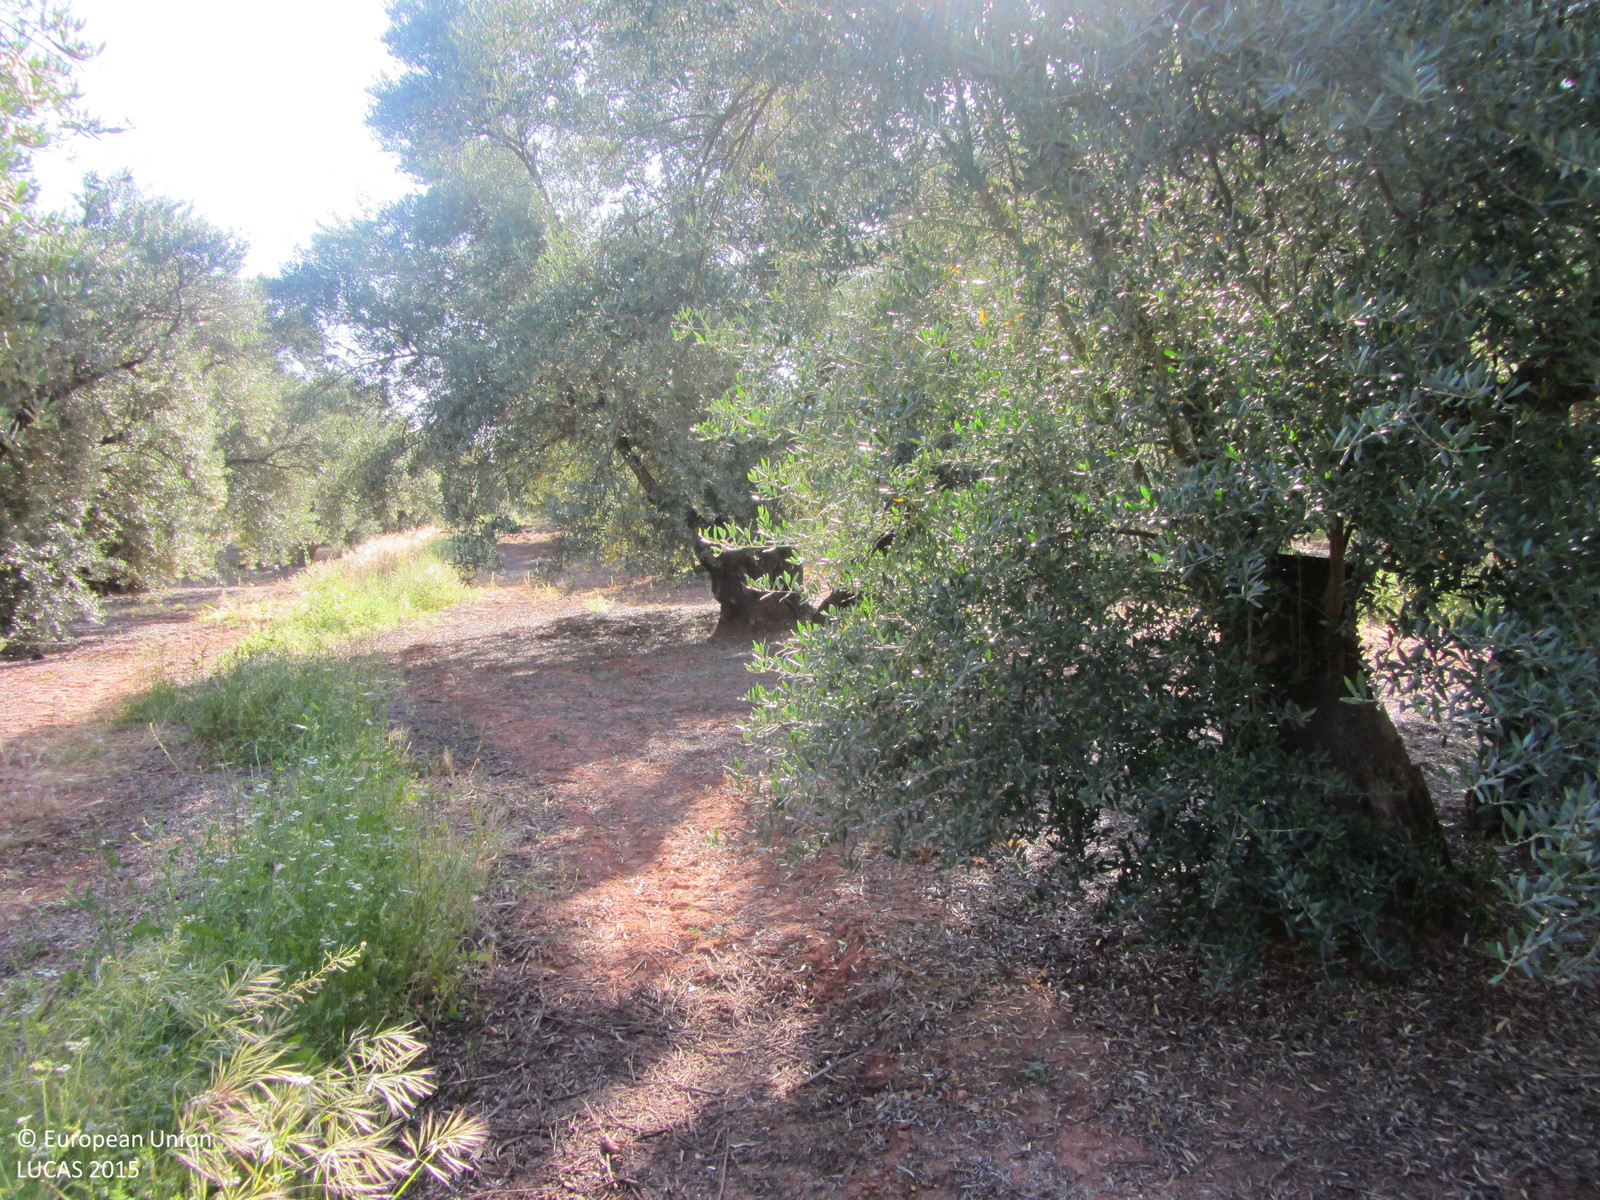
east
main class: Cropland
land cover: Olive groves
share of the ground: 50 - 75 %
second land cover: Spontaneously vegetated surfaces
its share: 10 - 25 %
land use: Agriculture (excluding fallow land and kitchen gardens)
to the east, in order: Olive groves; Spontaneously vegetated surfaces; Tracks; Olive groves; Electric lines; Olive groves; Broadleaved woodland; Inland fresh running water; Broadleaved woodland; Olive groves
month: May
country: ES
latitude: 38.1737
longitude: -3.1157
